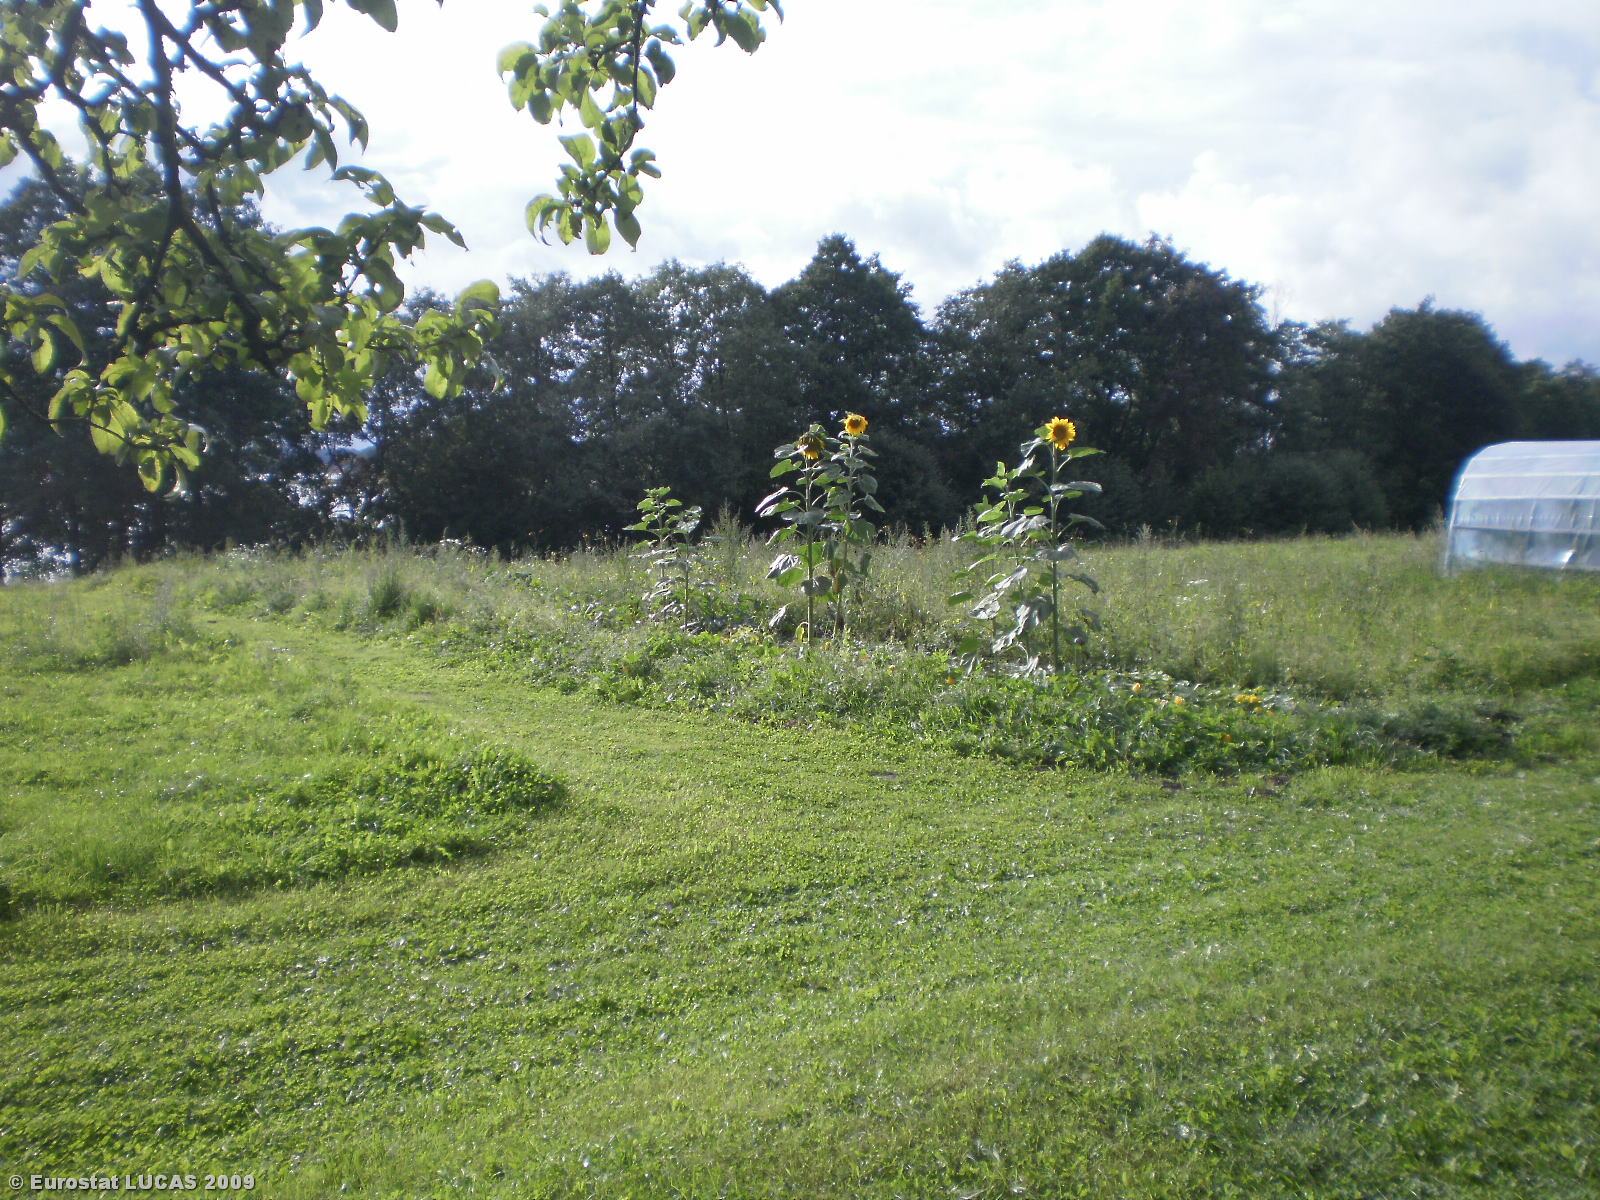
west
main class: Grassland
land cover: Grassland with sparse tree/shrub cover
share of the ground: > 75 %
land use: Residential
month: August
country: LT
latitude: 55.2446
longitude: 25.5892
